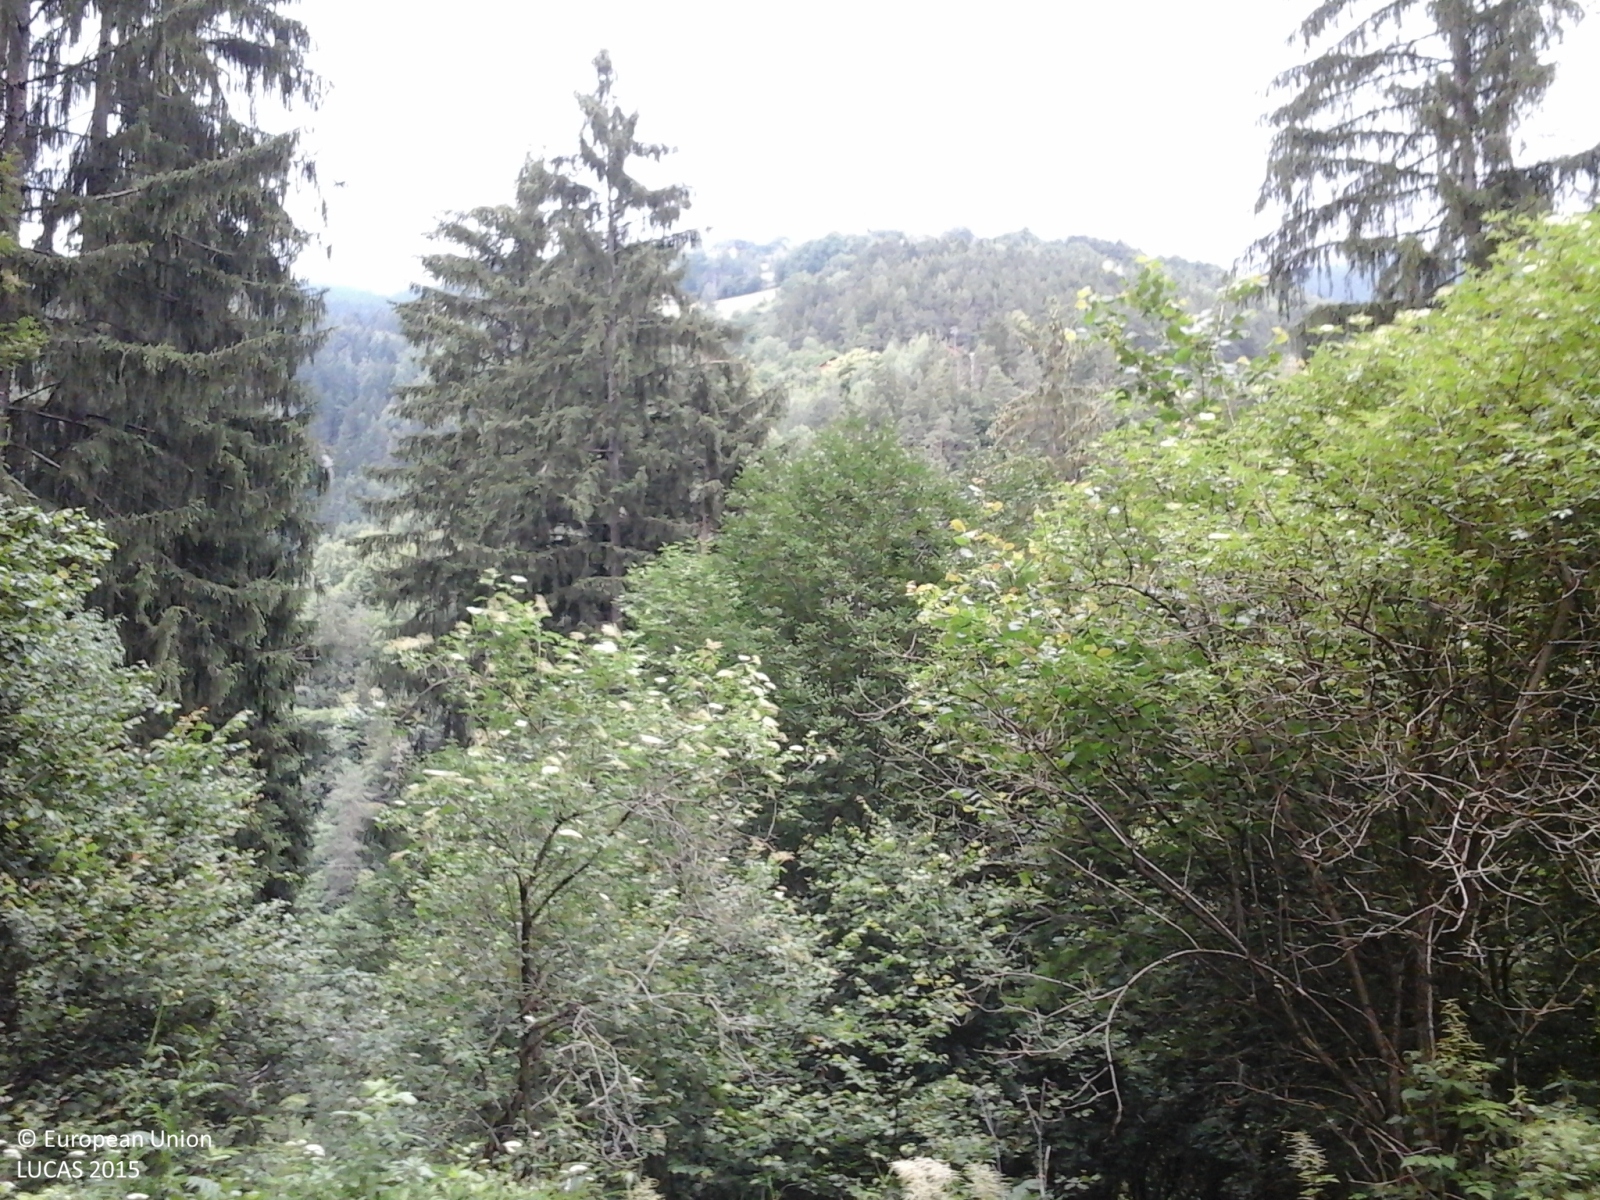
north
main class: Woodland
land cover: Spruce dominated coniferous woodland
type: alpine coniferous forest
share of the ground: > 75 %
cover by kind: coniferous forest trees 100 %
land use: Forestry
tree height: < 5 m
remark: Clear cut
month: June
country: IT
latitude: 46.5914
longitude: 11.6036
